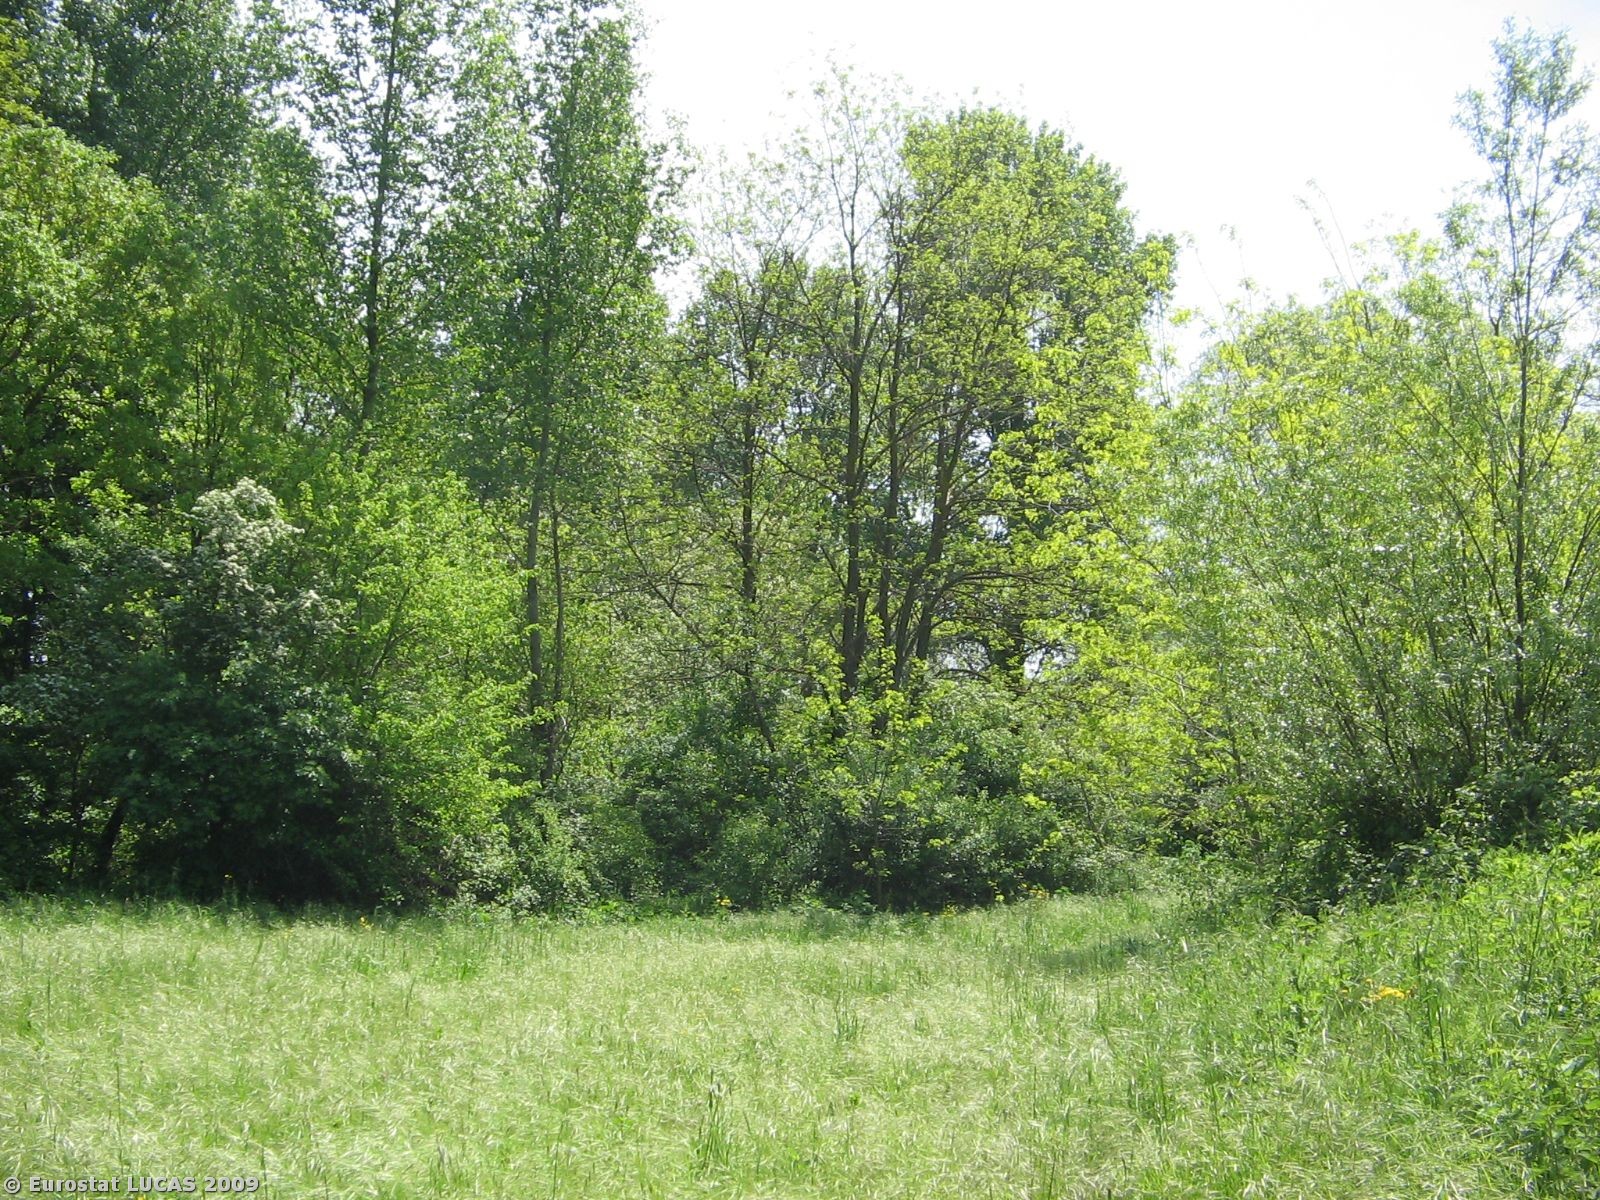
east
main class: Cropland
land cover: Temporary grasslands
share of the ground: > 75 %
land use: Agriculture (excluding fallow land and kitchen gardens)
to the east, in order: Temporary grasslands; Mixed woodland; Arable land (only in case pi); Oats
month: May
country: IT
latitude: 41.5470
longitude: 14.3600
